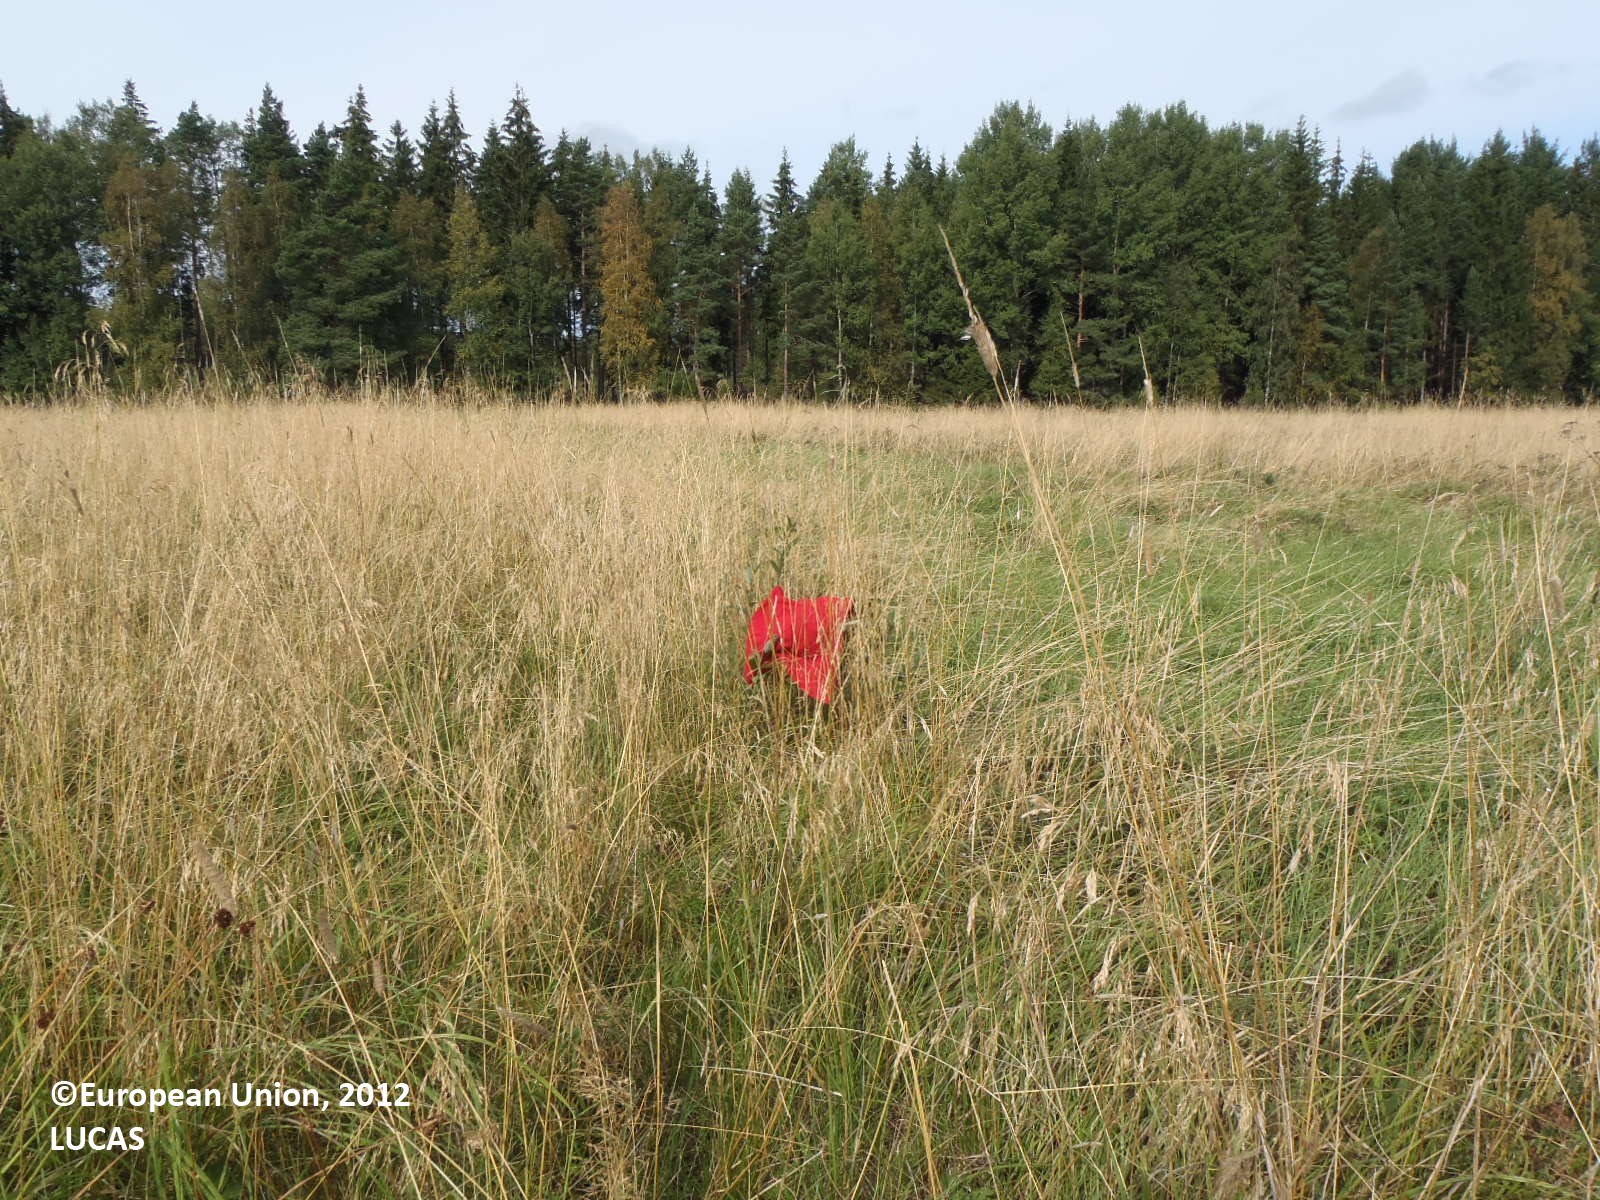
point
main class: Cropland
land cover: Temporary grasslands
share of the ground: > 75 %
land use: Agriculture (excluding fallow land and kitchen gardens)
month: August
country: FI
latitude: 60.7134
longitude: 22.5496
